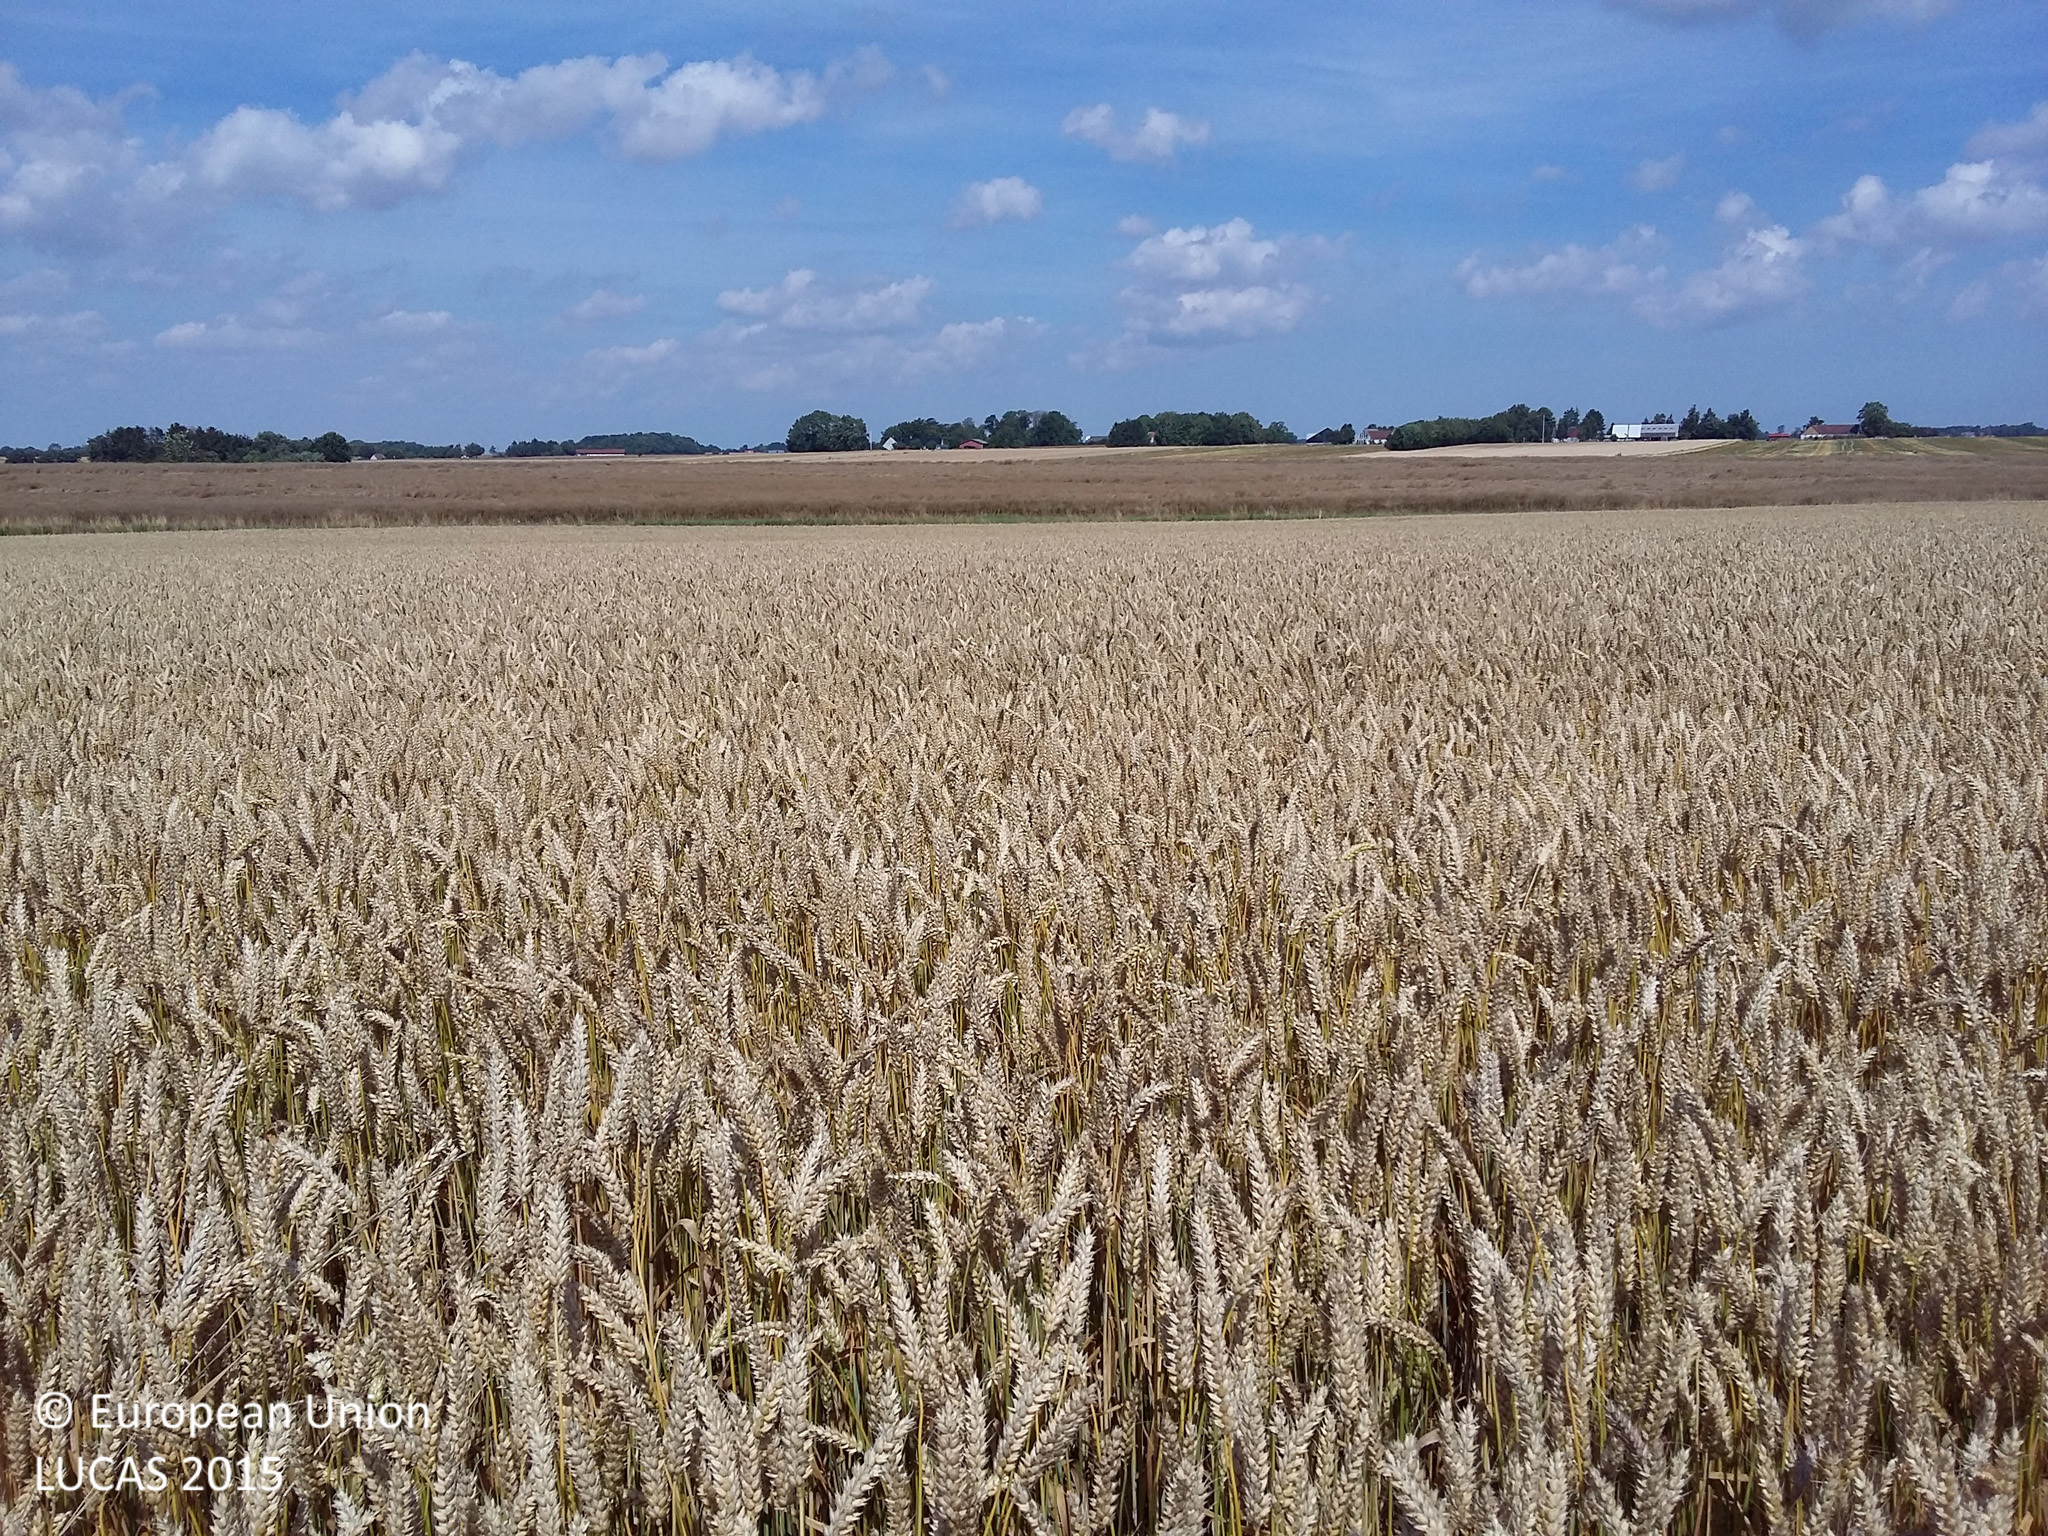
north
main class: Cropland
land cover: Common wheat
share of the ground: > 75 %
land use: Agriculture (excluding fallow land and kitchen gardens)
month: August
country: DK
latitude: 55.3825
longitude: 11.9083
